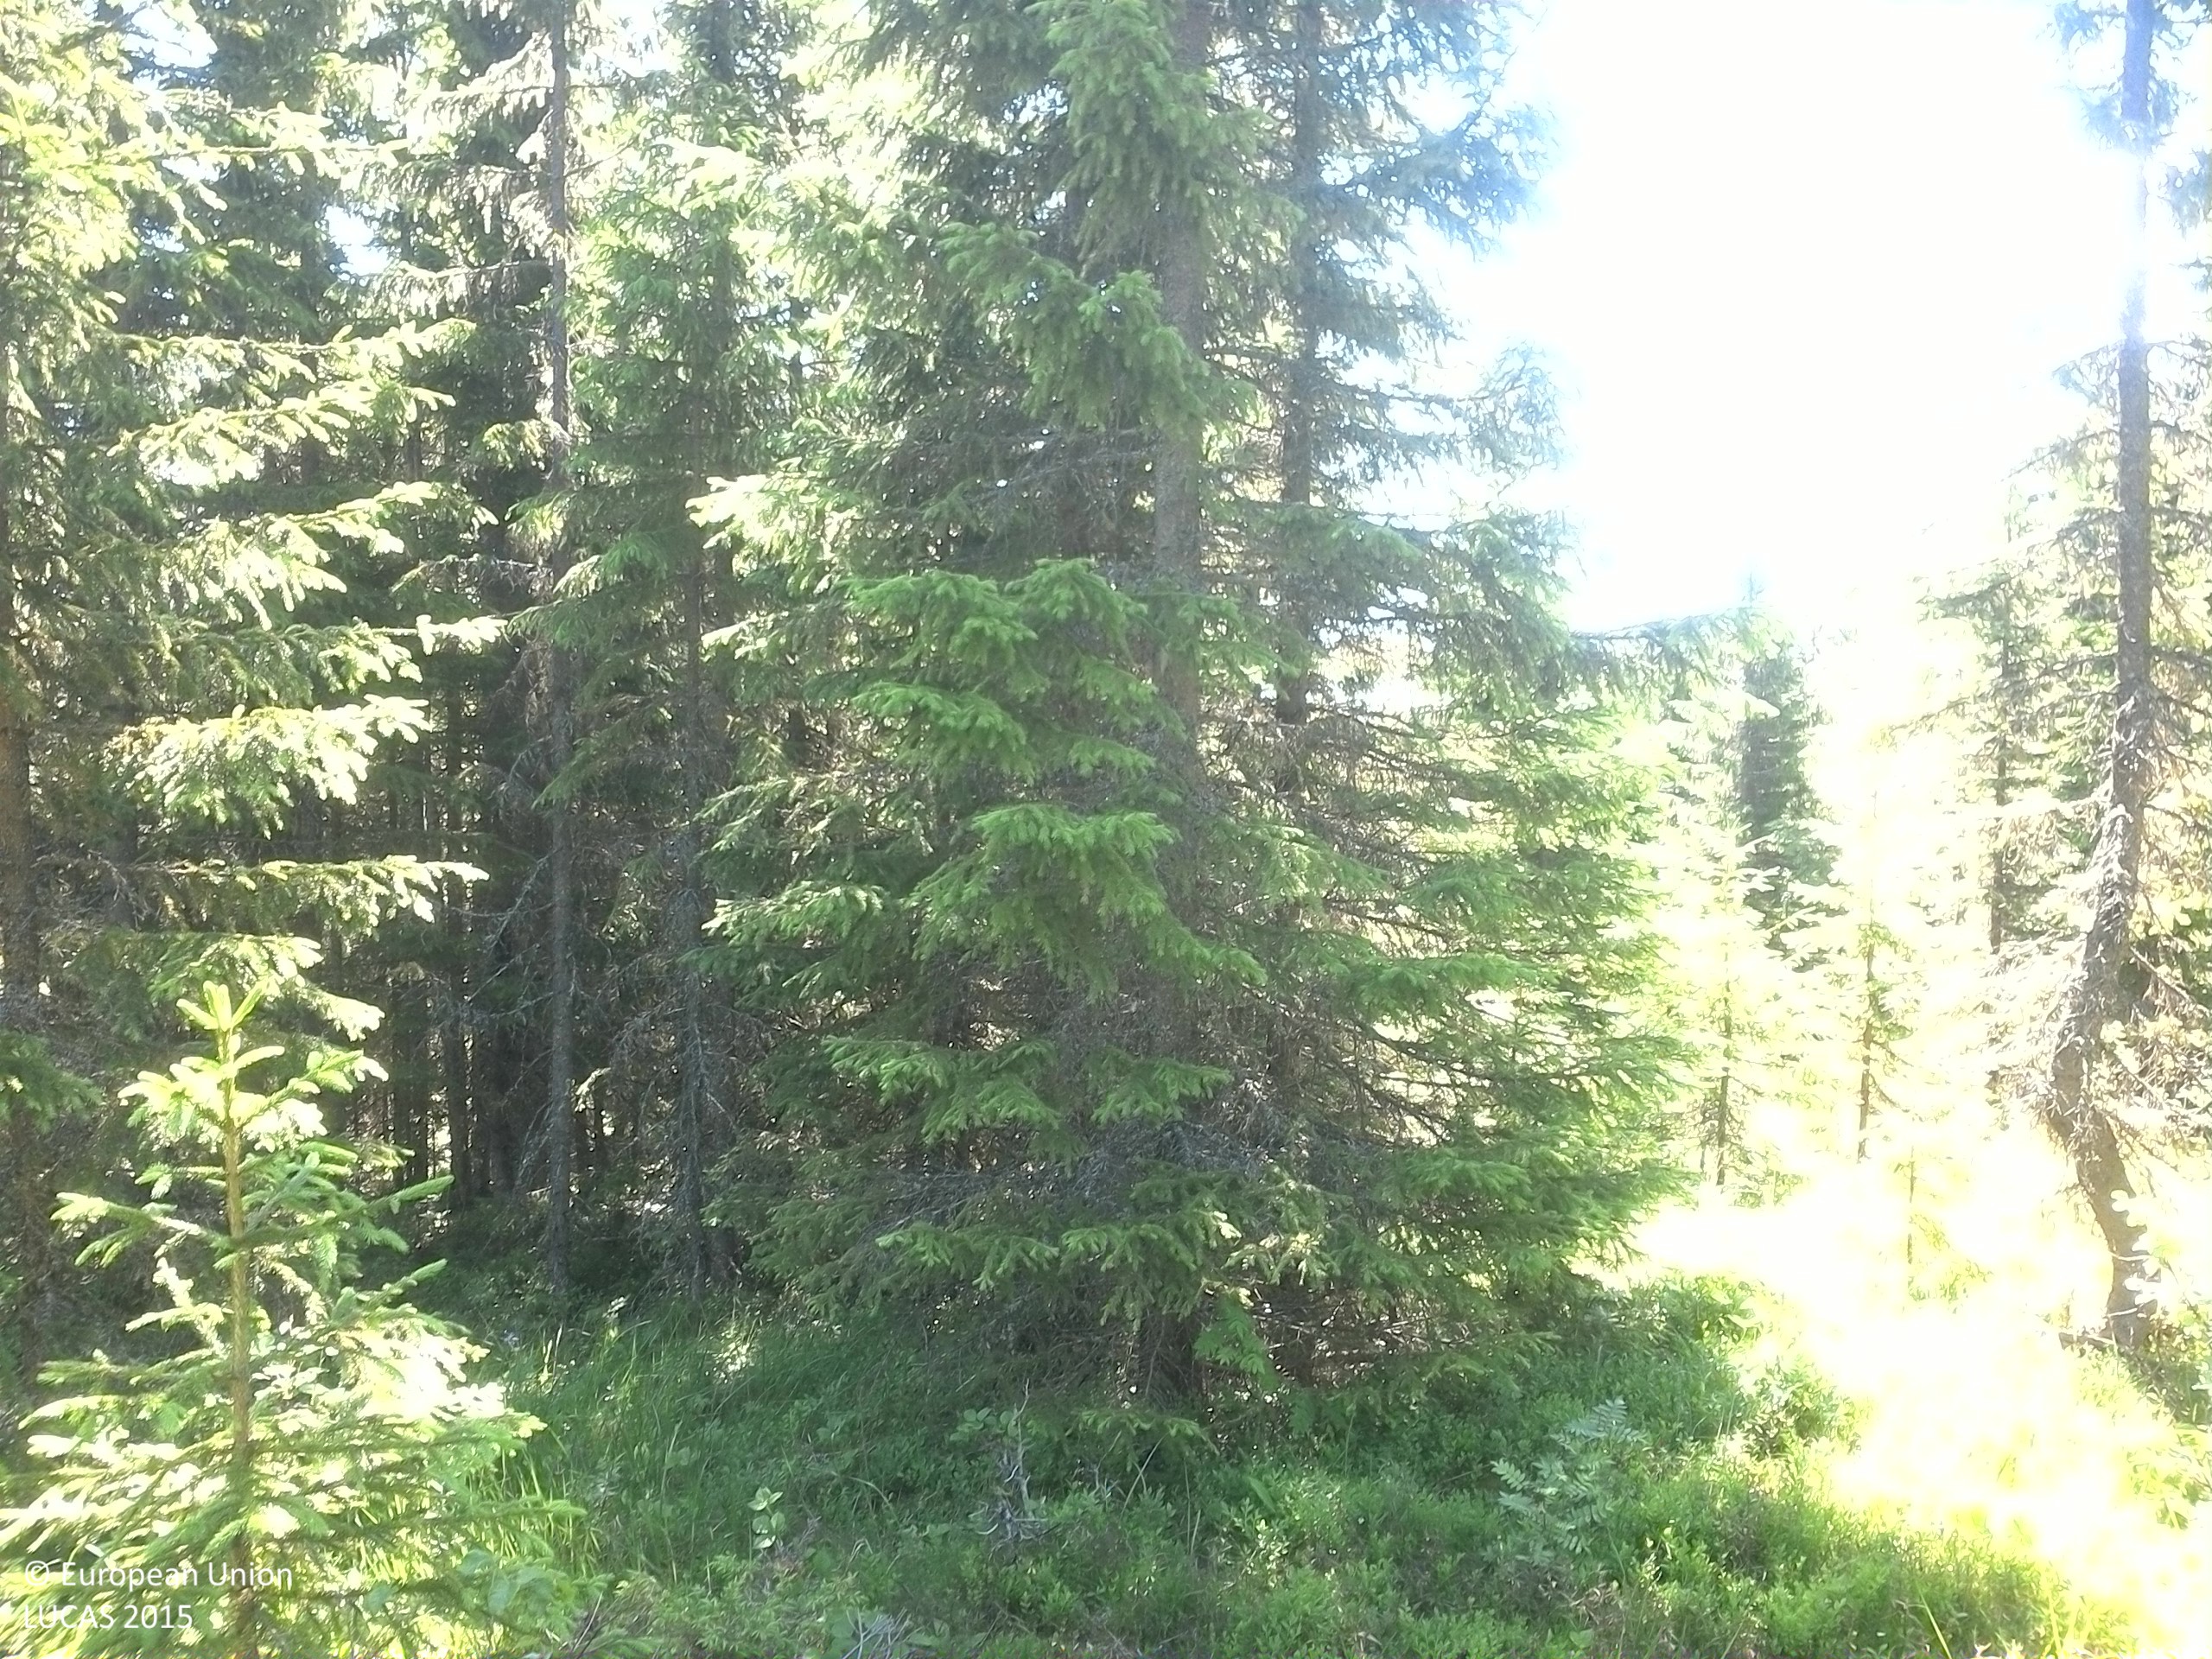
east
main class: Woodland
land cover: Spruce dominated coniferous woodland
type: boreal forest
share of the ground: 25 - 50 %
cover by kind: coniferous forest trees 40 %, herbaceous plants 30 %, shrubs 15 %, lichens and mosses 10 %, broadleaved forest trees 5 %
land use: Forestry
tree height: > 5 m
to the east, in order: Spruce dominated coniferous woodland; Spruce dominated mixed woodland
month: July
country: SE
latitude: 62.8007
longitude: 17.6069
